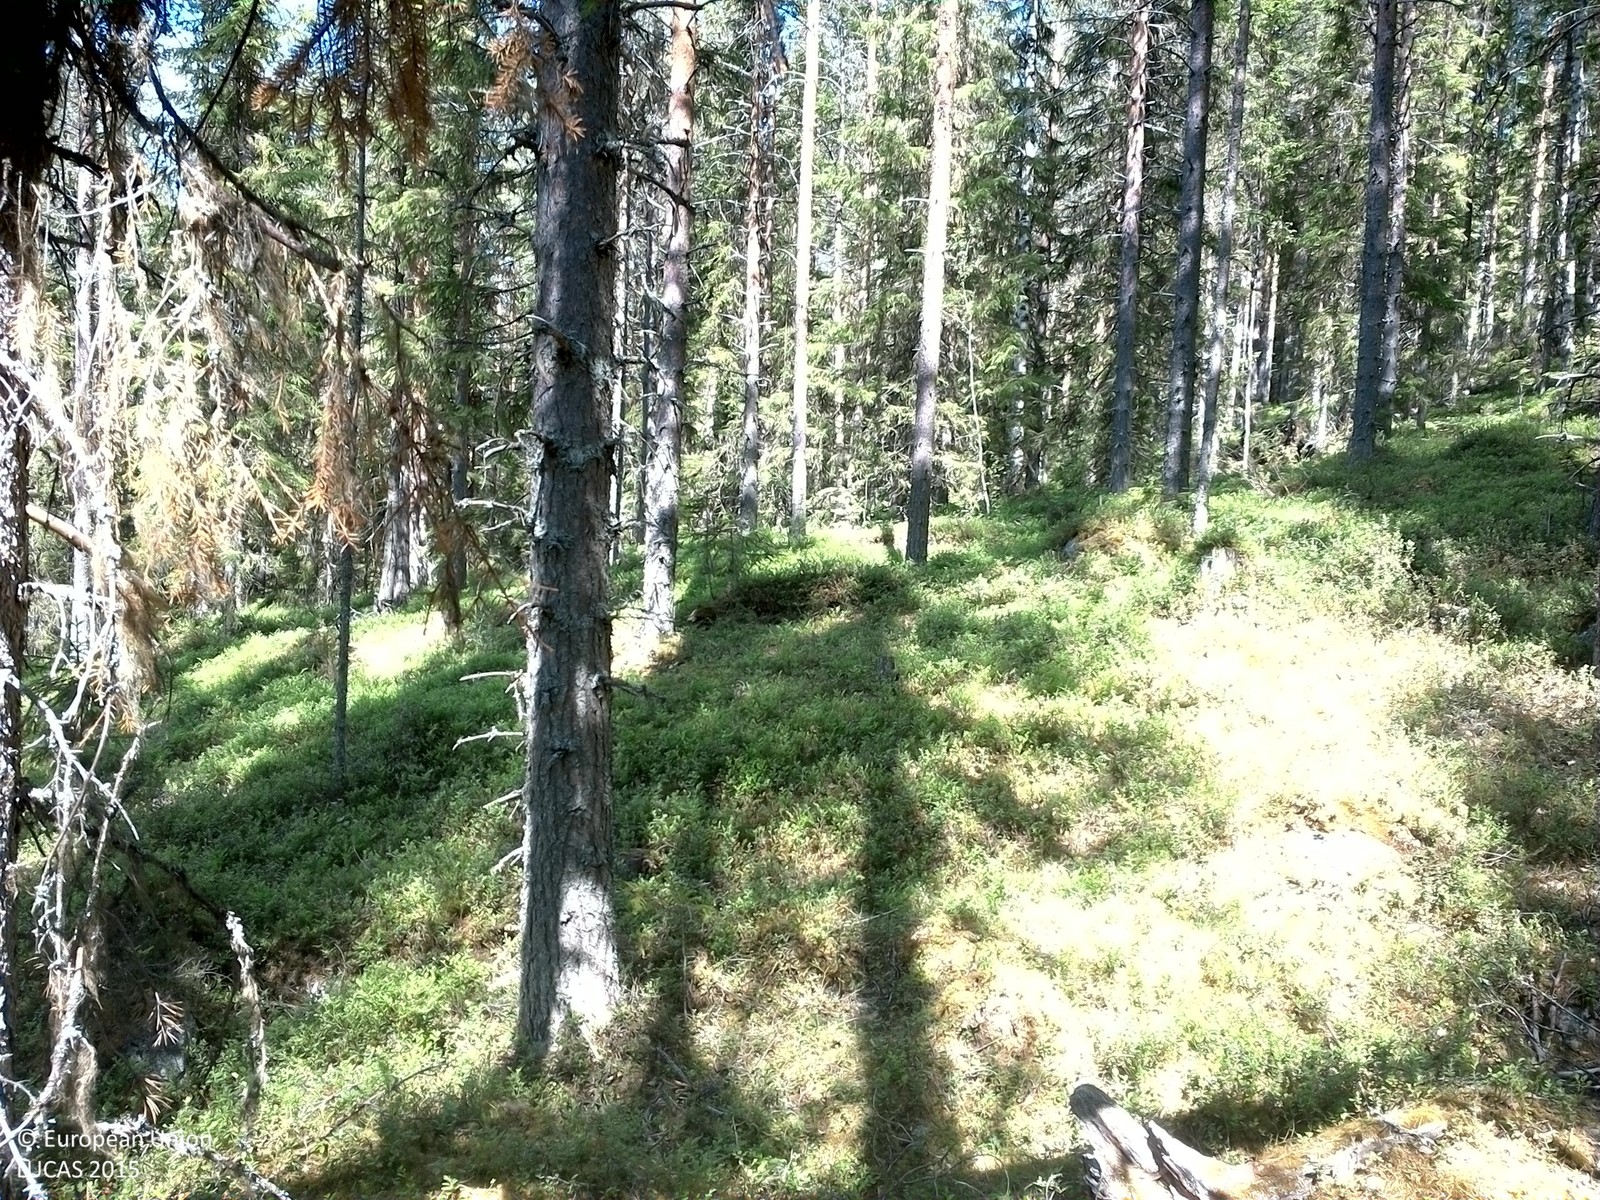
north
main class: Woodland
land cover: Pine dominated coniferous woodland
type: boreal forest
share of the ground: 50 - 75 %
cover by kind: coniferous forest trees 60 %, shrubs 25 %, lichens and mosses 10 %, broadleaved forest trees 5 %
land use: Forestry
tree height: > 5 m
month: July
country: SE
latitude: 64.2327
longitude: 16.8348
